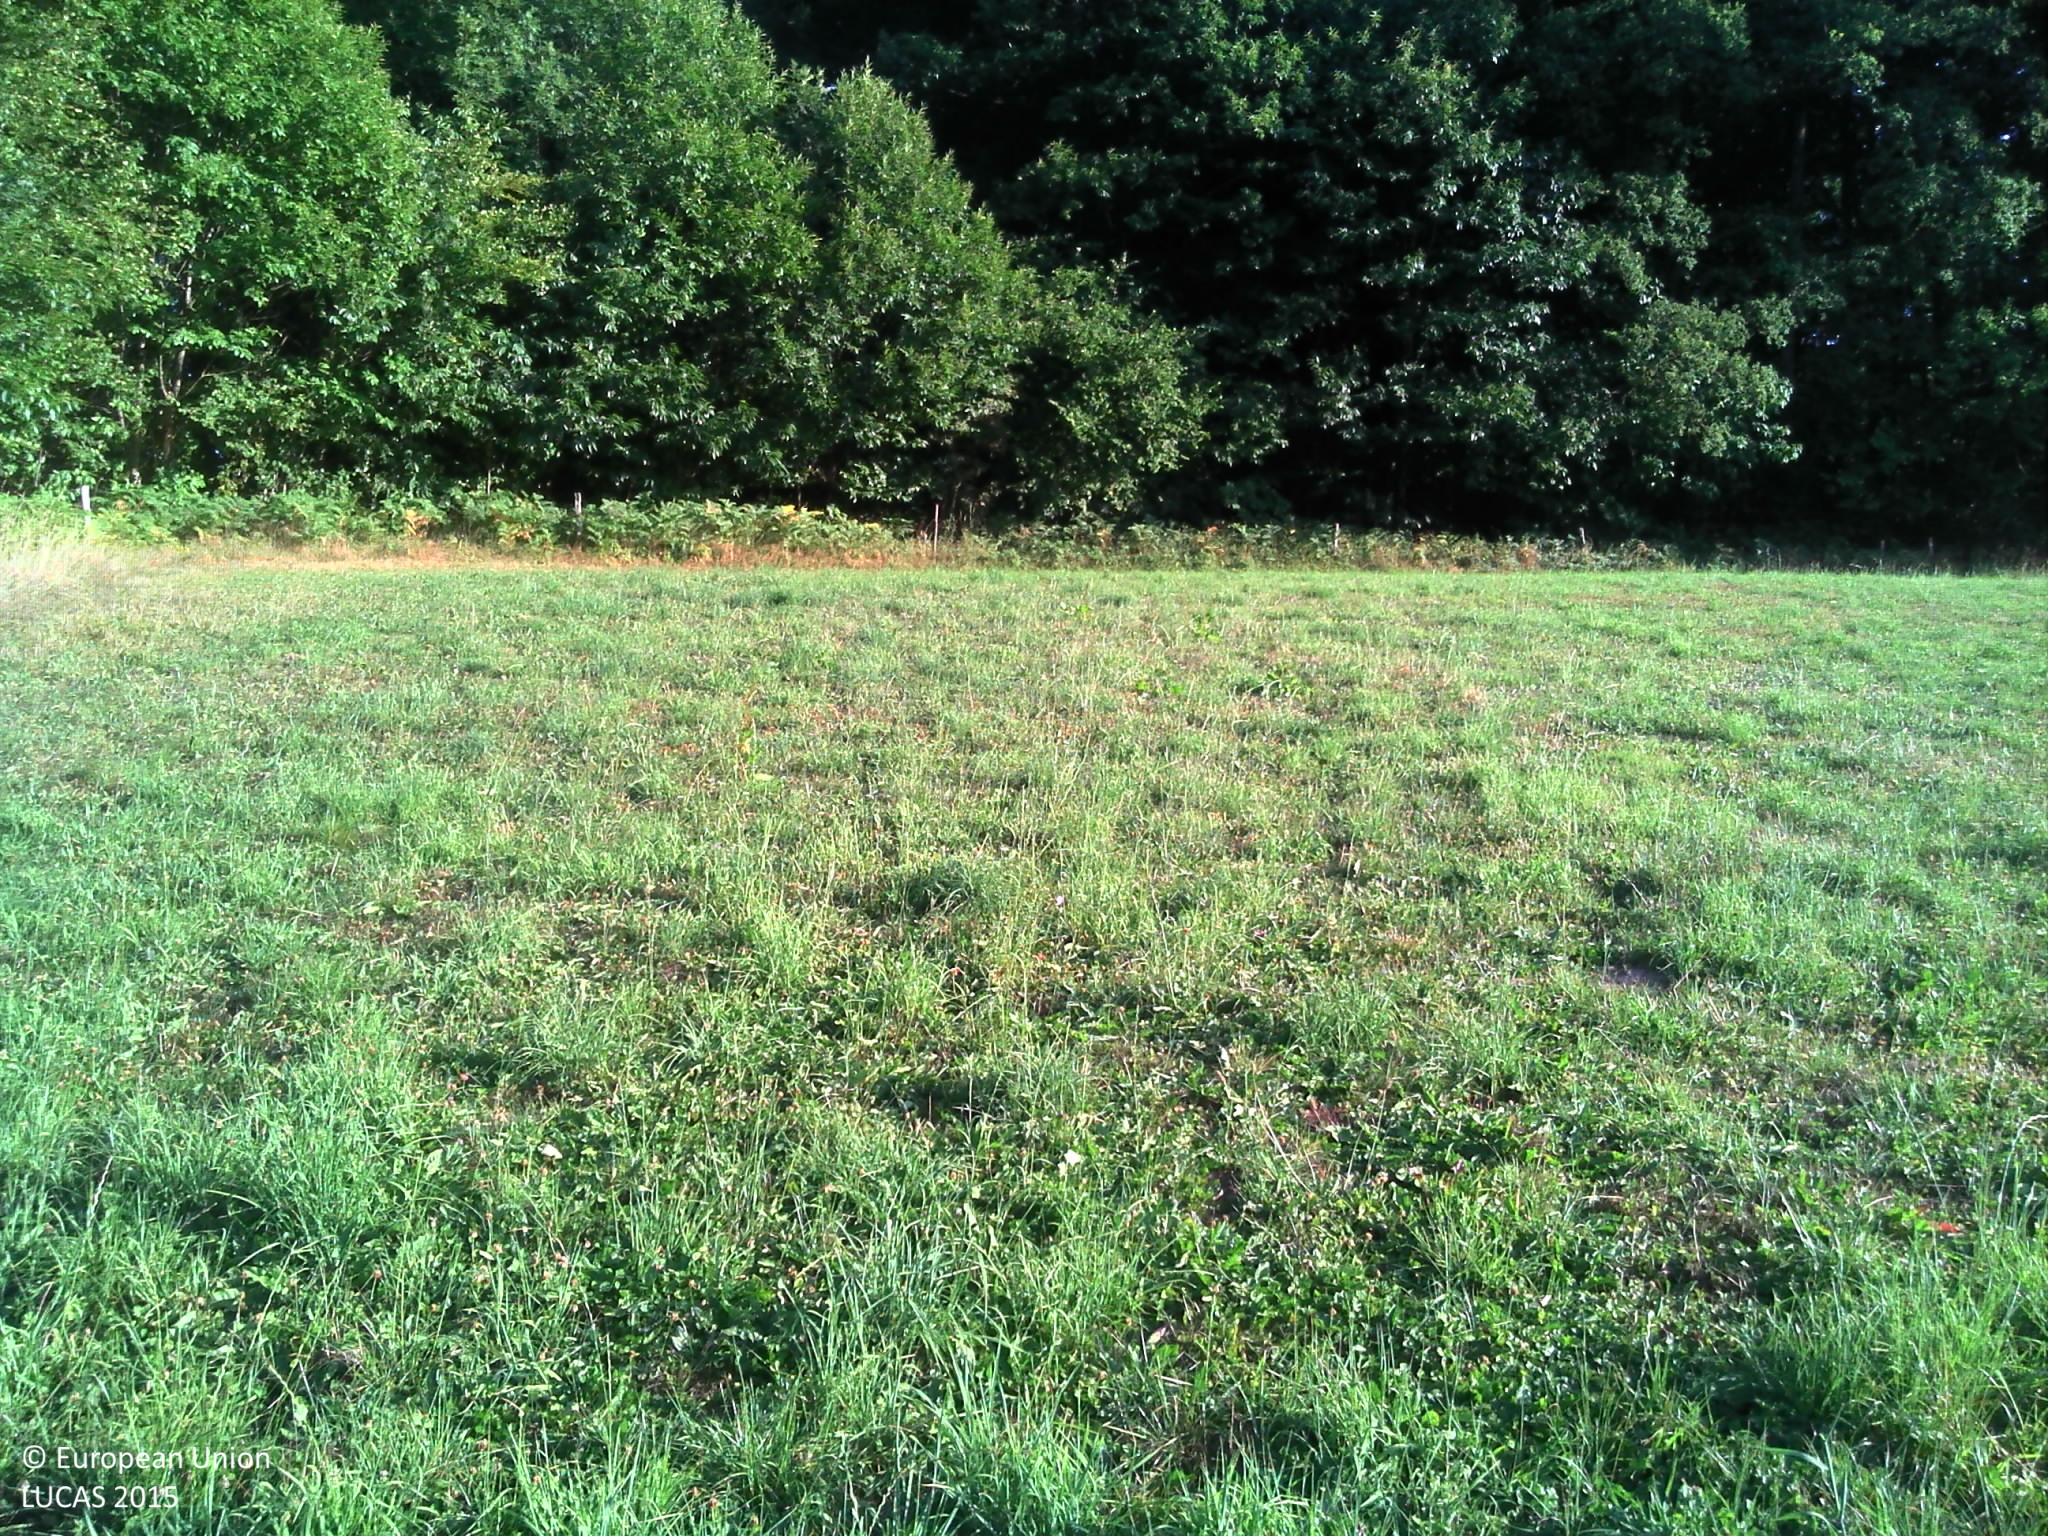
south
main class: Grassland
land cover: Grassland without tree/shrub cover
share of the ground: > 75 %
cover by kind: herbaceous plants 100 %
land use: Agriculture (excluding fallow land and kitchen gardens)
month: July
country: FR
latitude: 46.0629
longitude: 1.6803
